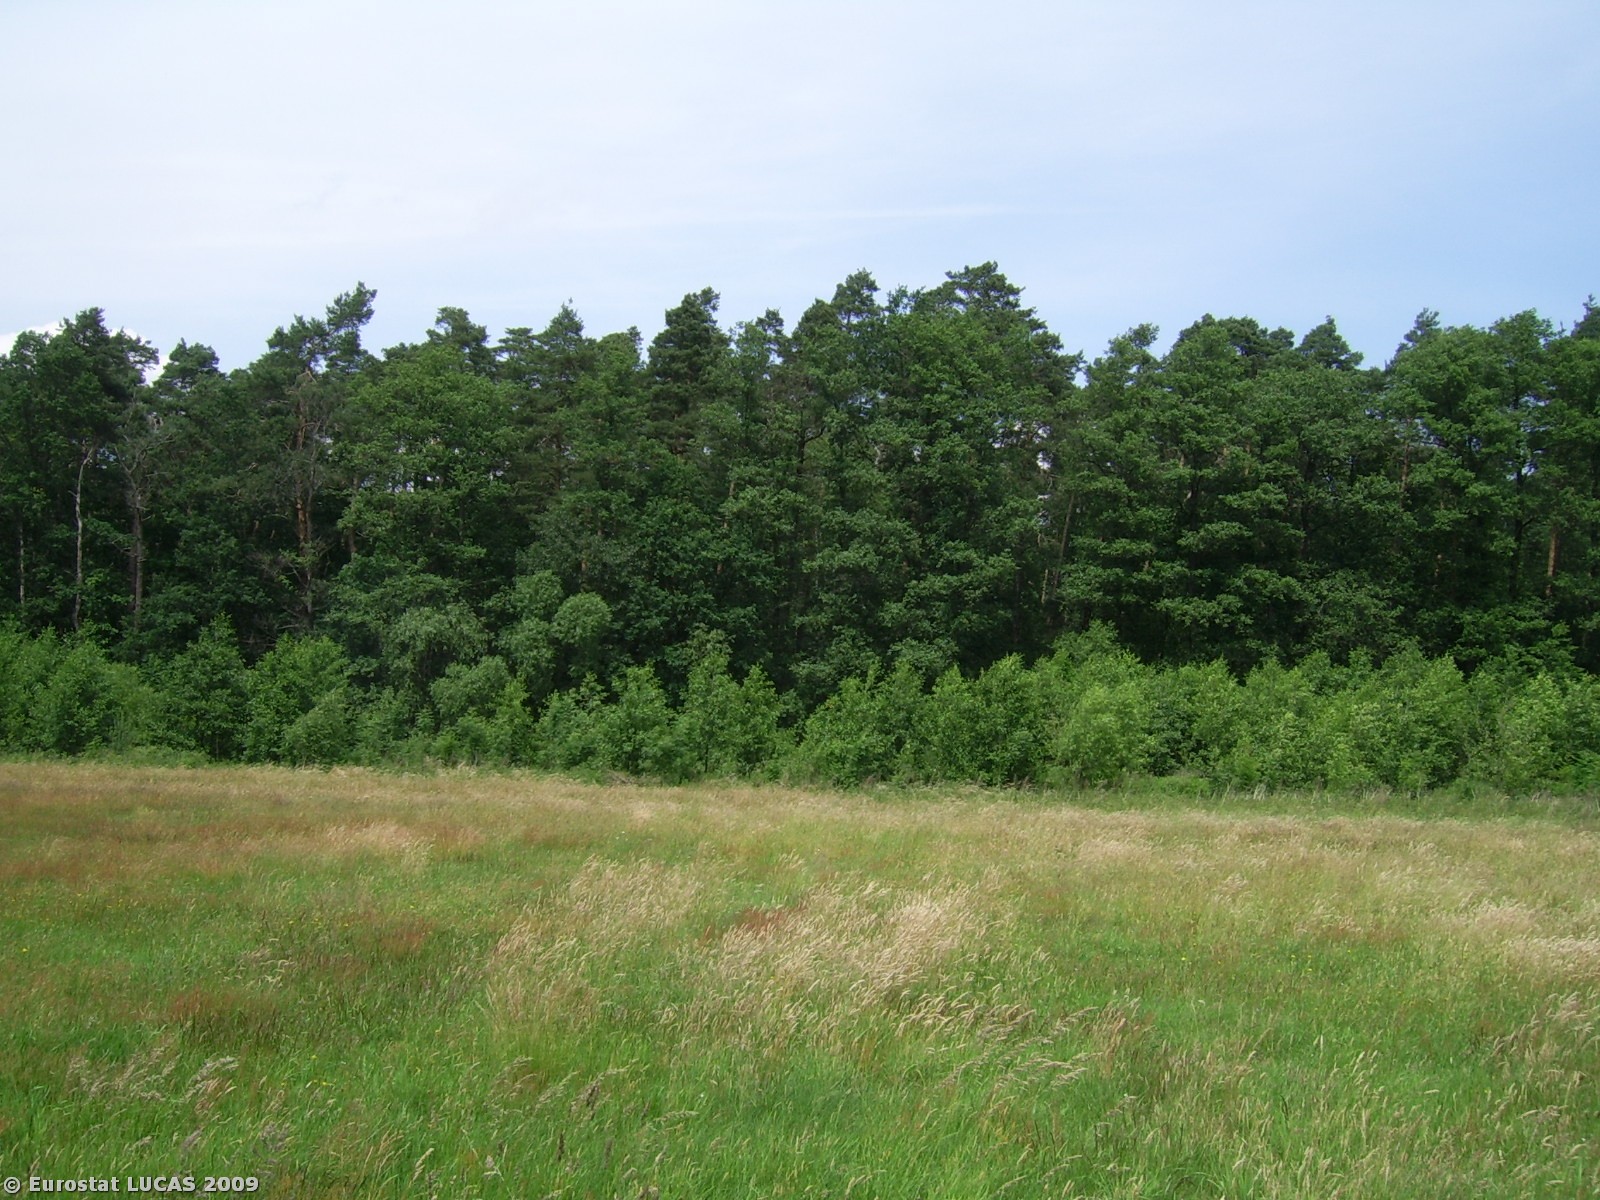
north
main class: Grassland
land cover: Grassland without tree/shrub cover
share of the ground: > 75 %
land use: Agriculture (excluding fallow land and kitchen gardens)
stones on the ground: < 10 %
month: June
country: PL
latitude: 51.4943
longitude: 17.9810
